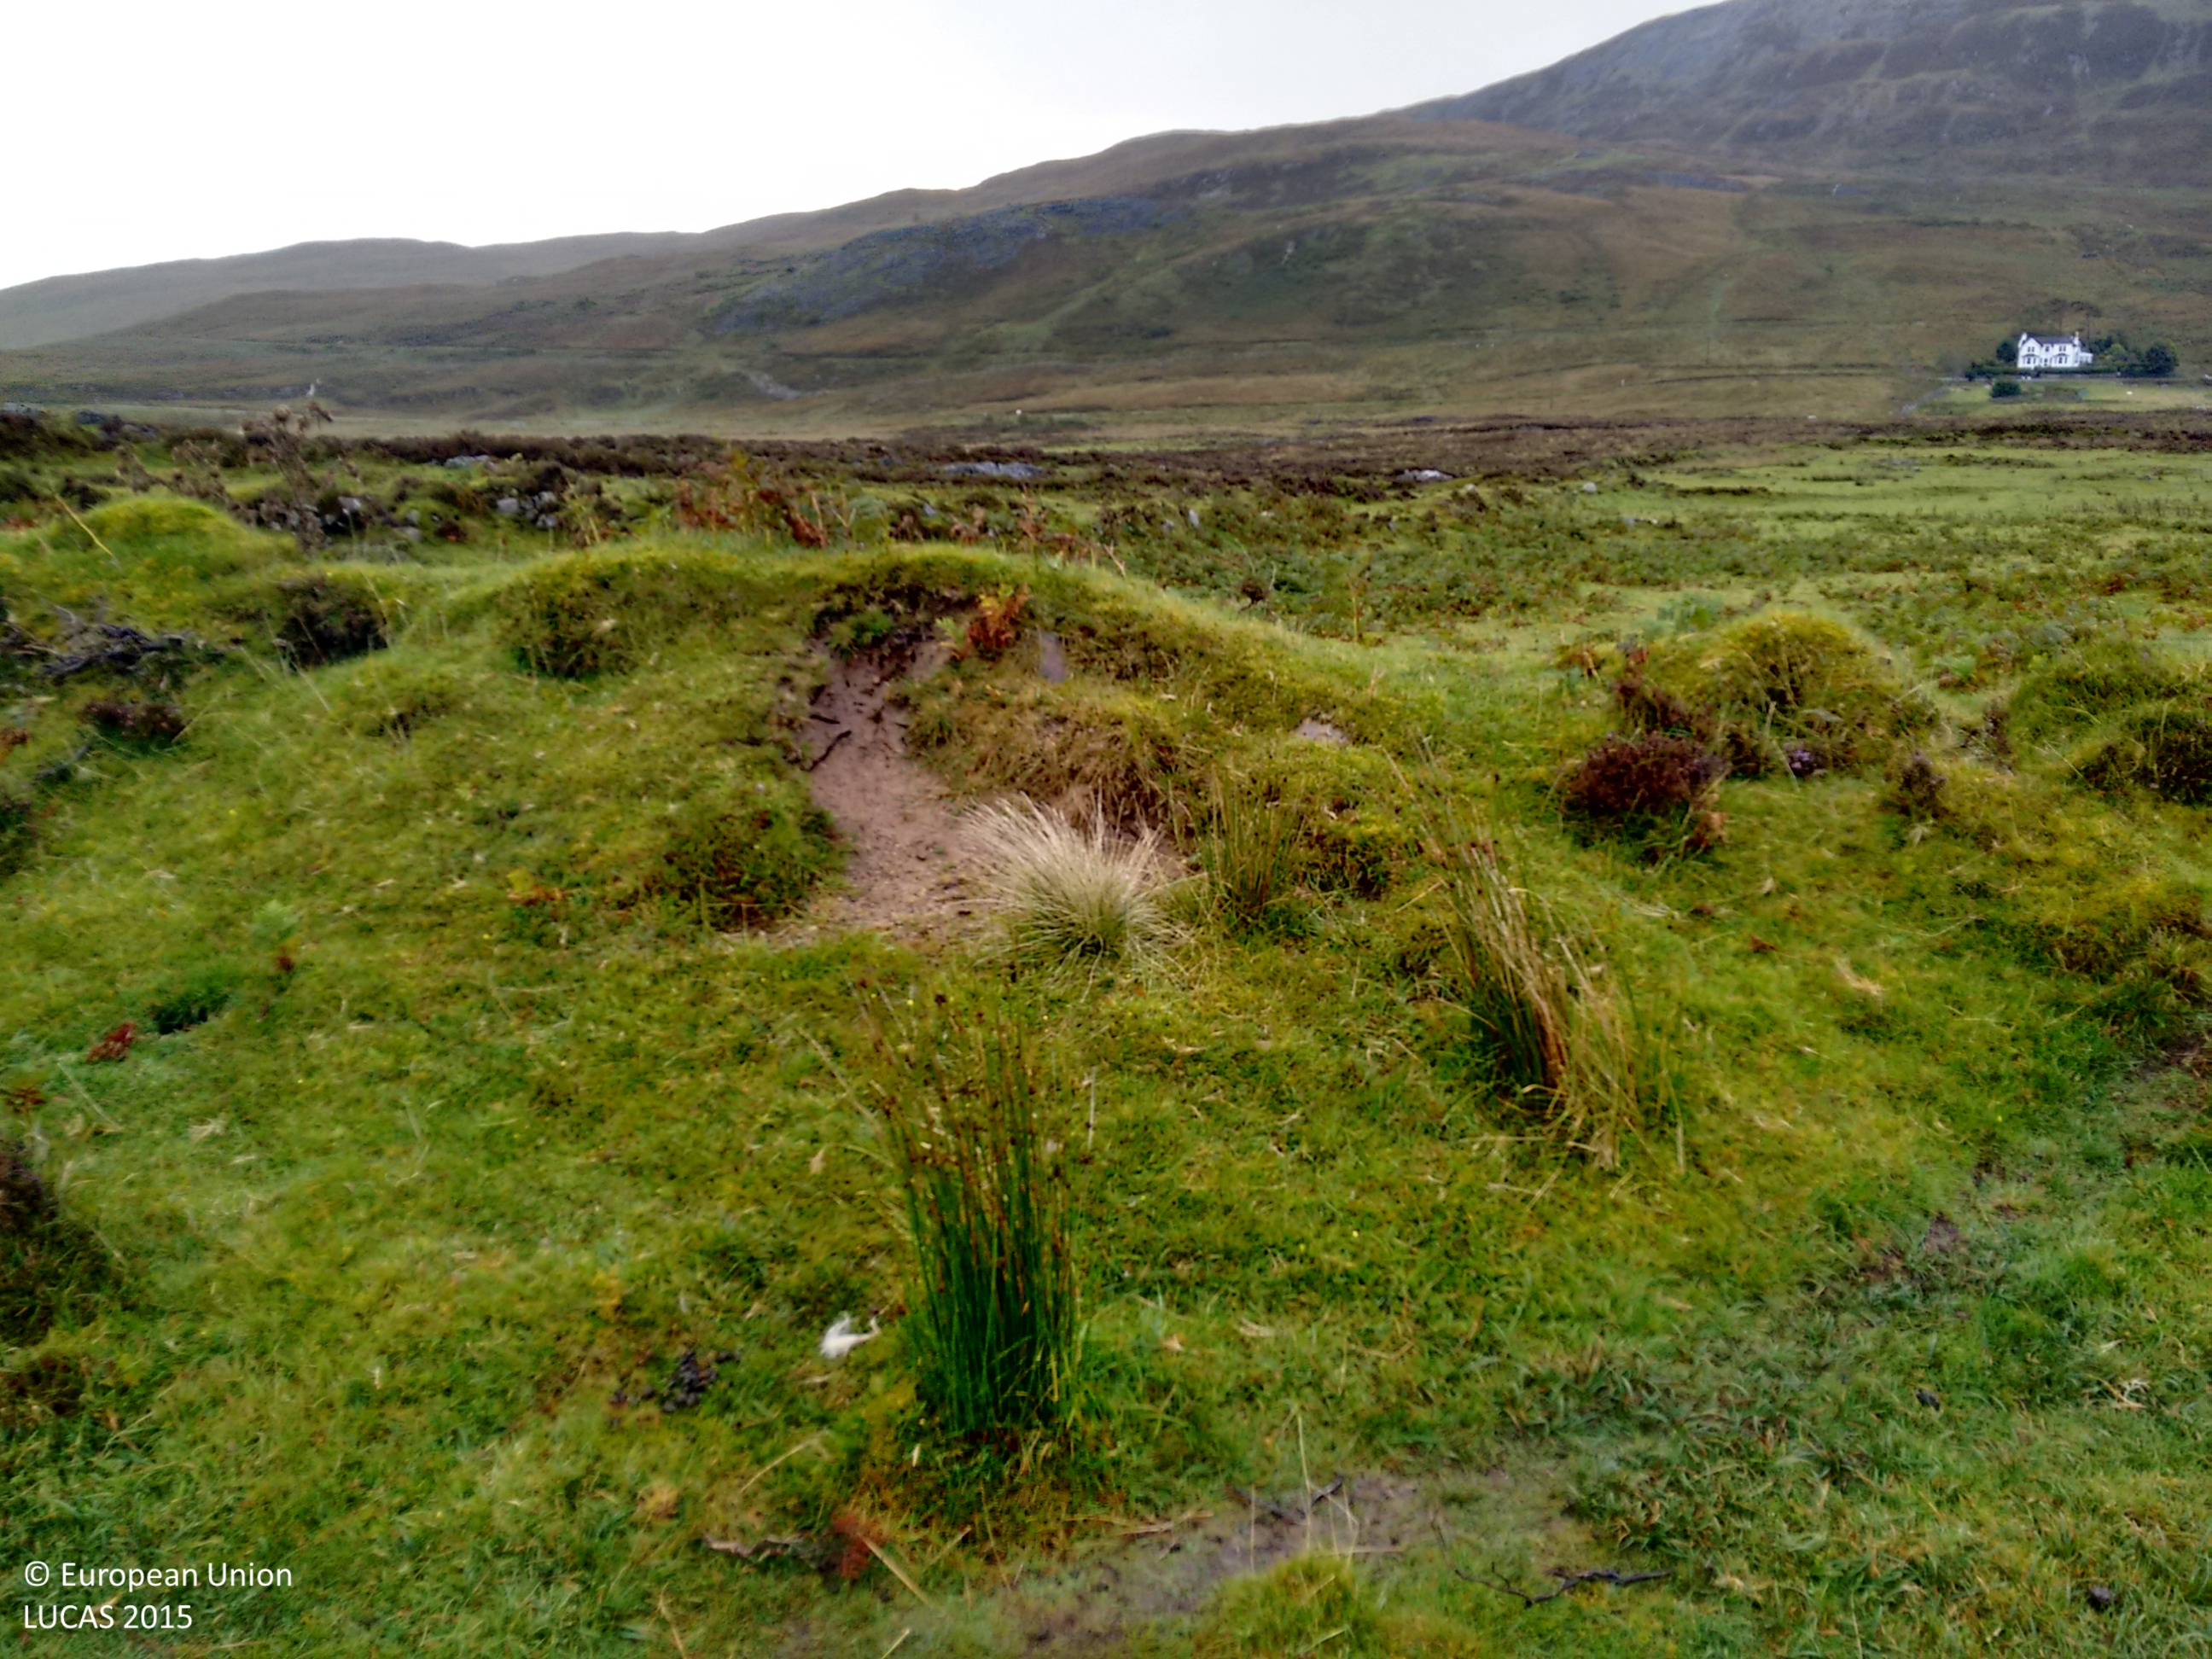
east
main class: Shrubland
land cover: Shrubland without tree cover
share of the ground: > 75 %
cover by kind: shrubs 75 %, herbaceous plants 25 %
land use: Agriculture (excluding fallow land and kitchen gardens)
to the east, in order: Shrubland without tree cover; Grassland without tree/shrub cover; Shrubland without tree cover; Grassland without tree/shrub cover; Shrubland without tree cover
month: September
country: GB
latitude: 57.2214
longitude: -5.9443
